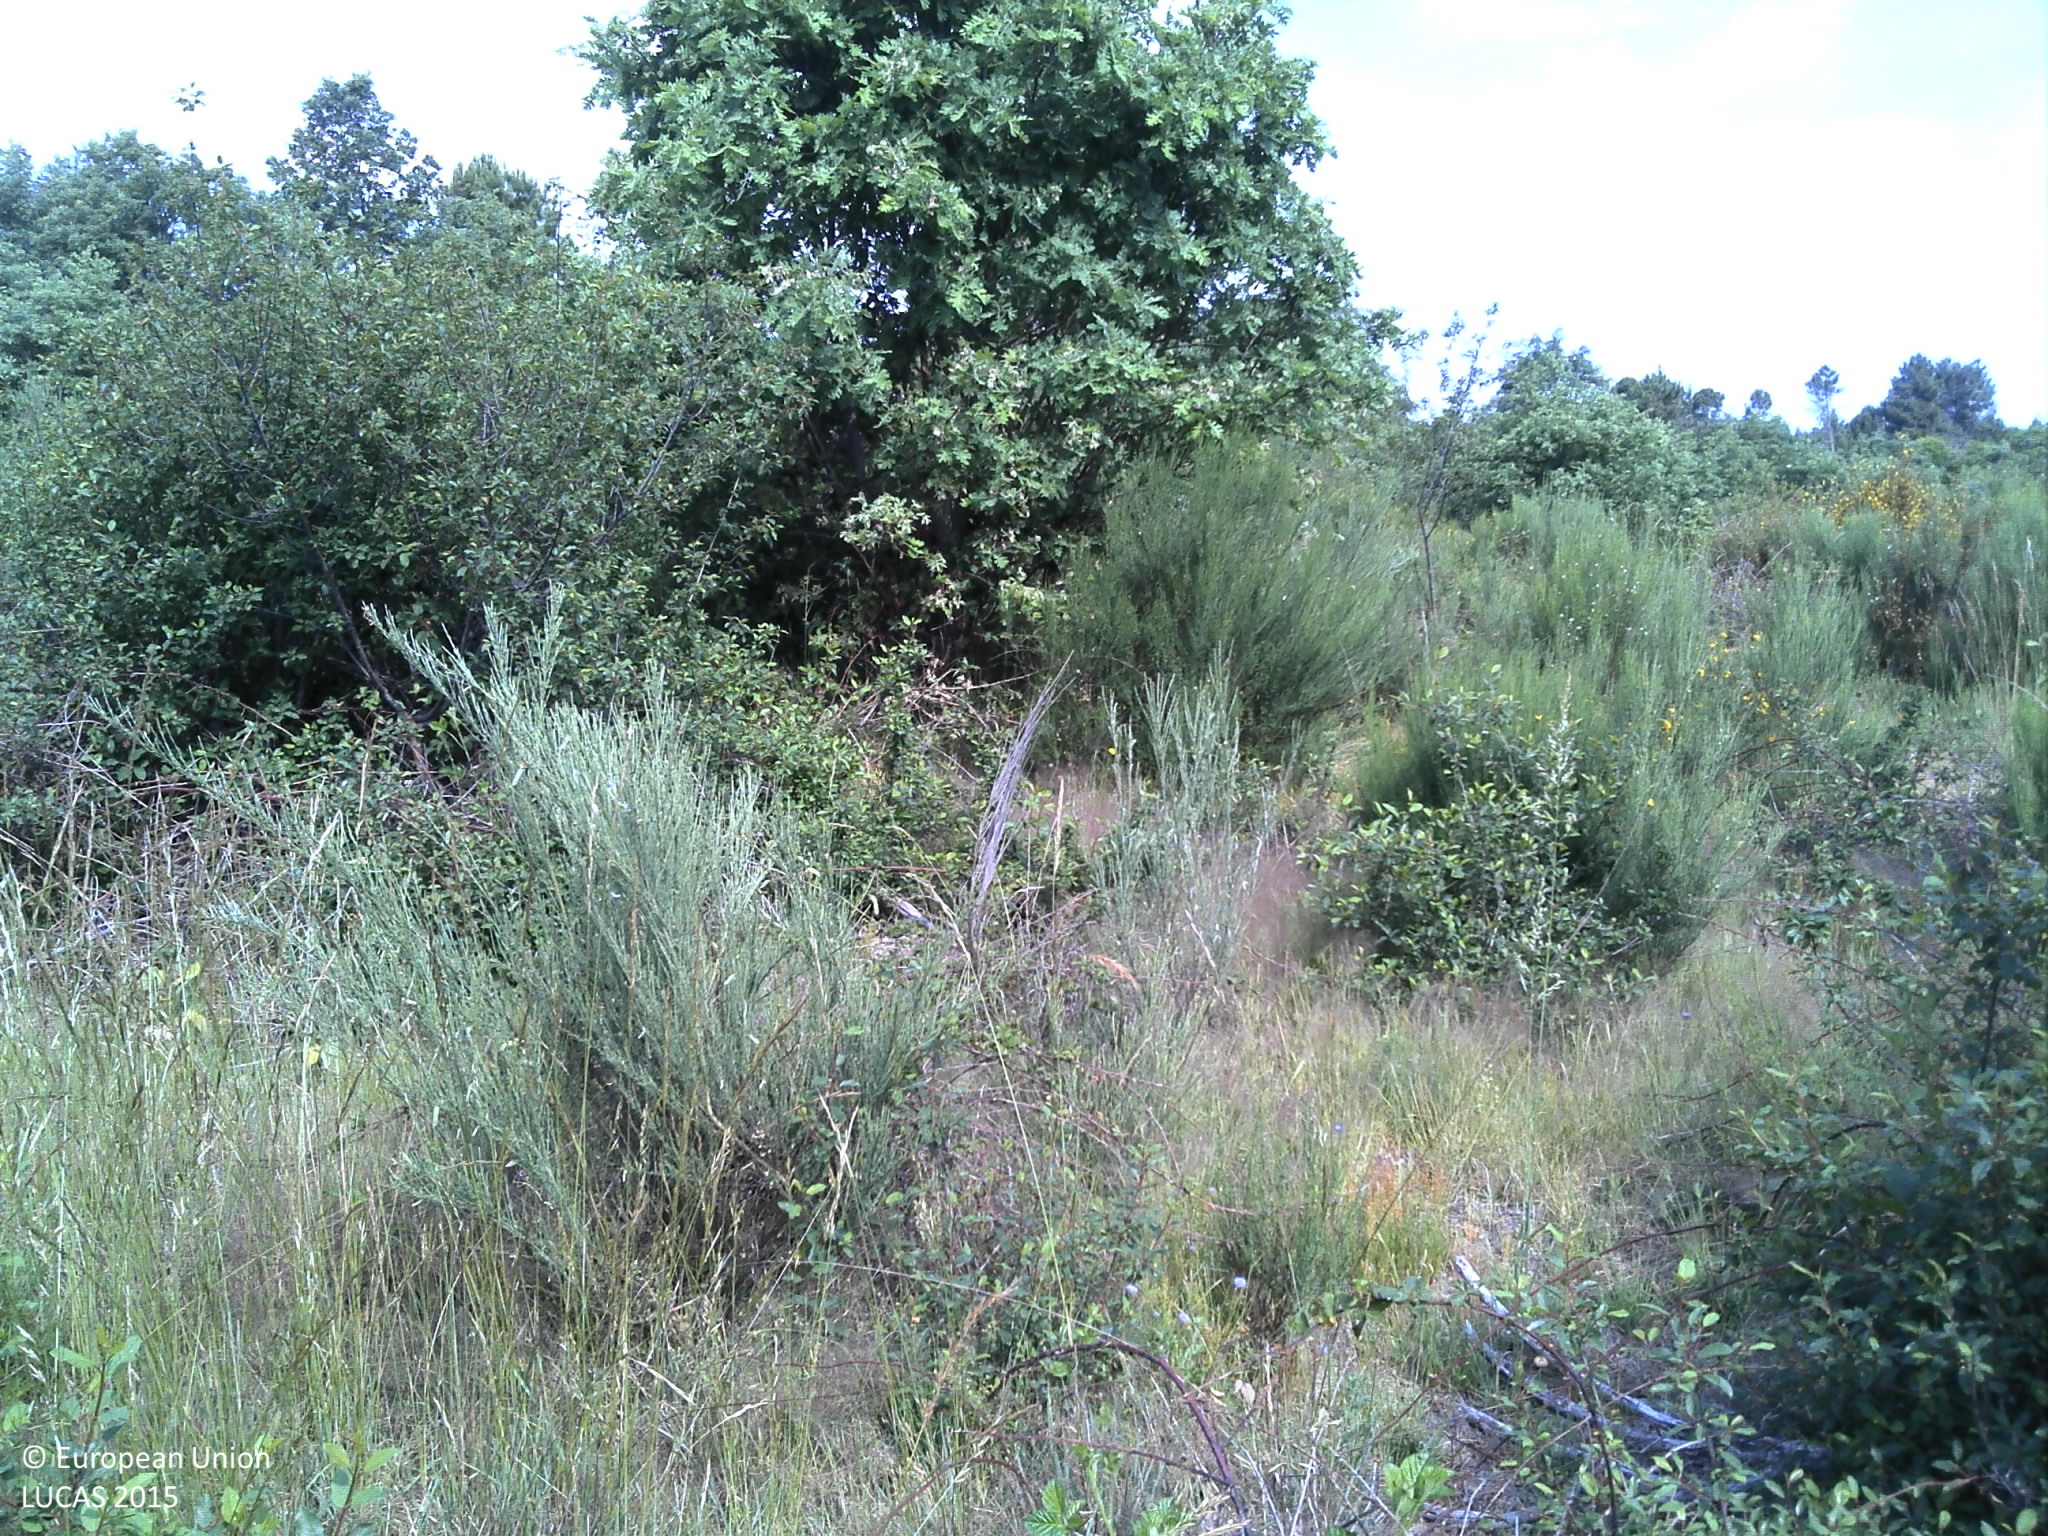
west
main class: Shrubland
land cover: Shrubland with sparse tree cover
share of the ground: > 75 %
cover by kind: shrubs 95 %, broadleaved forest trees 5 %
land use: Semi-natural and natural areas not in use
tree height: > 5 m
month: June
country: PT
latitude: 41.4409
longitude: -7.5417
